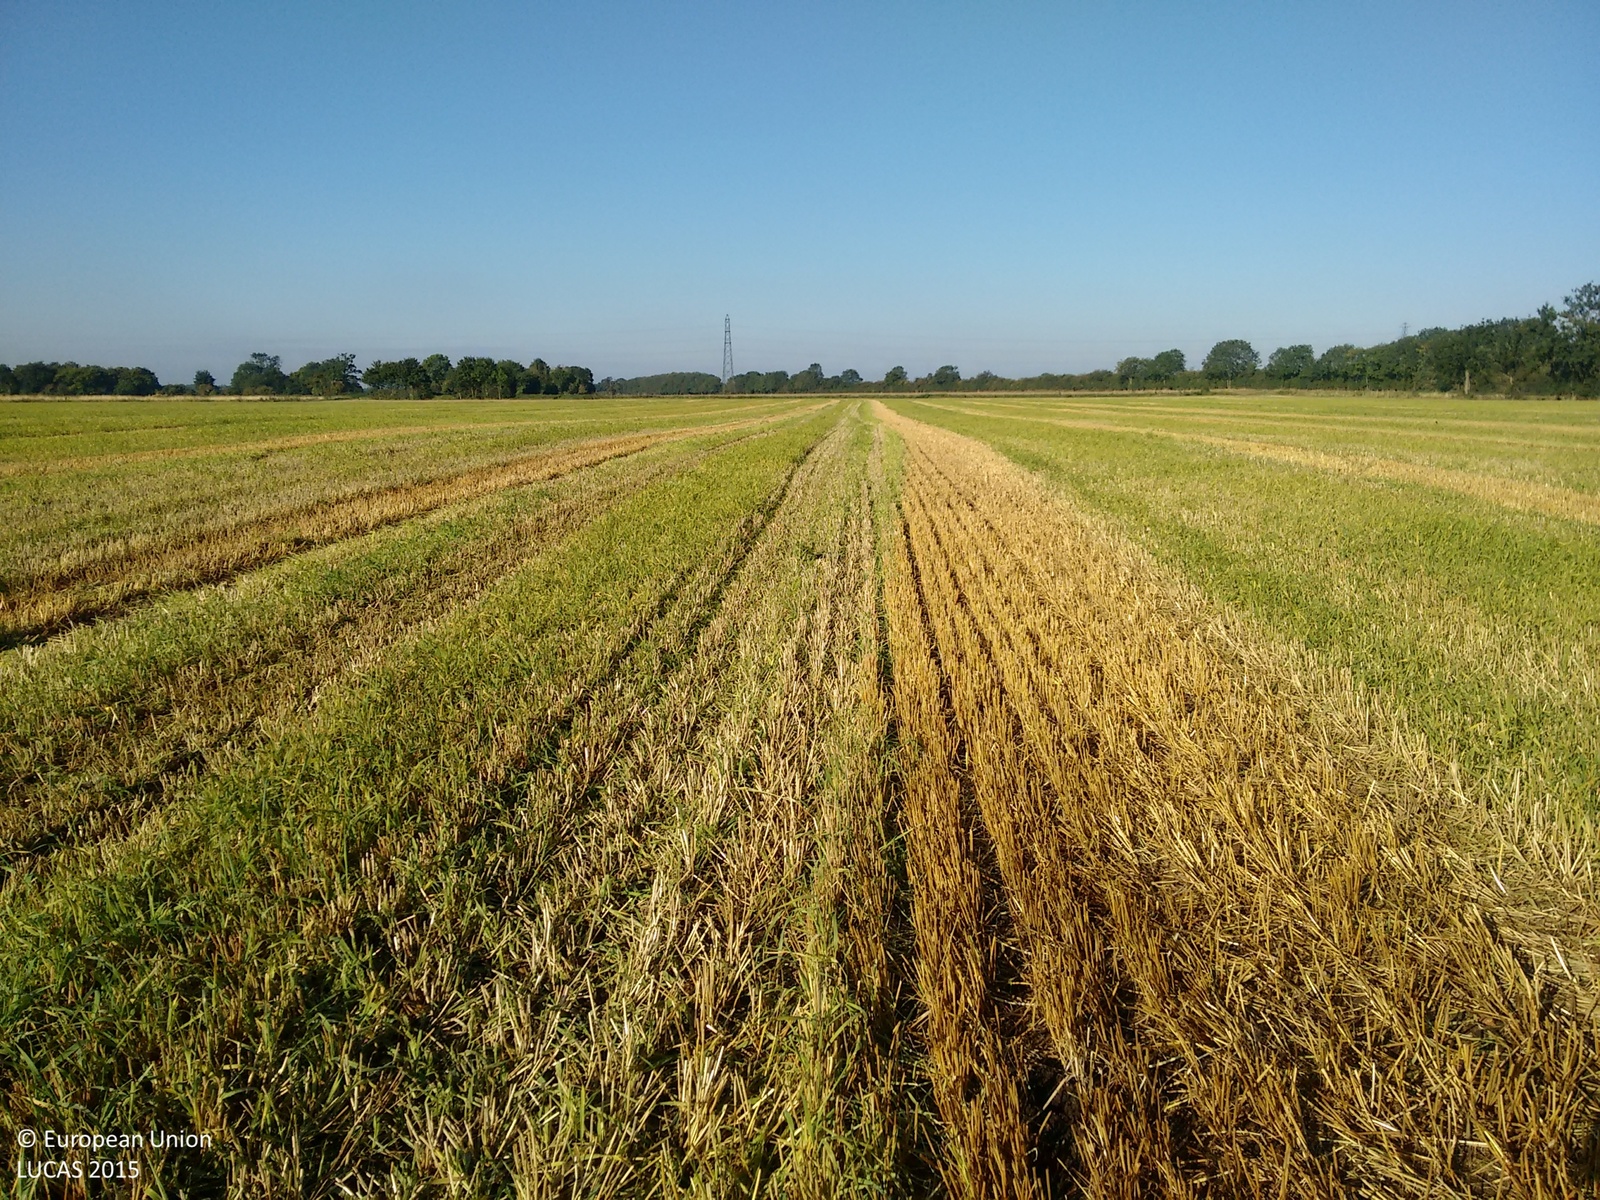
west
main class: Cropland
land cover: Barley
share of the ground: > 75 %
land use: Agriculture (excluding fallow land and kitchen gardens)
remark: Harvested field
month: September
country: GB
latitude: 52.2251
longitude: 0.2049
